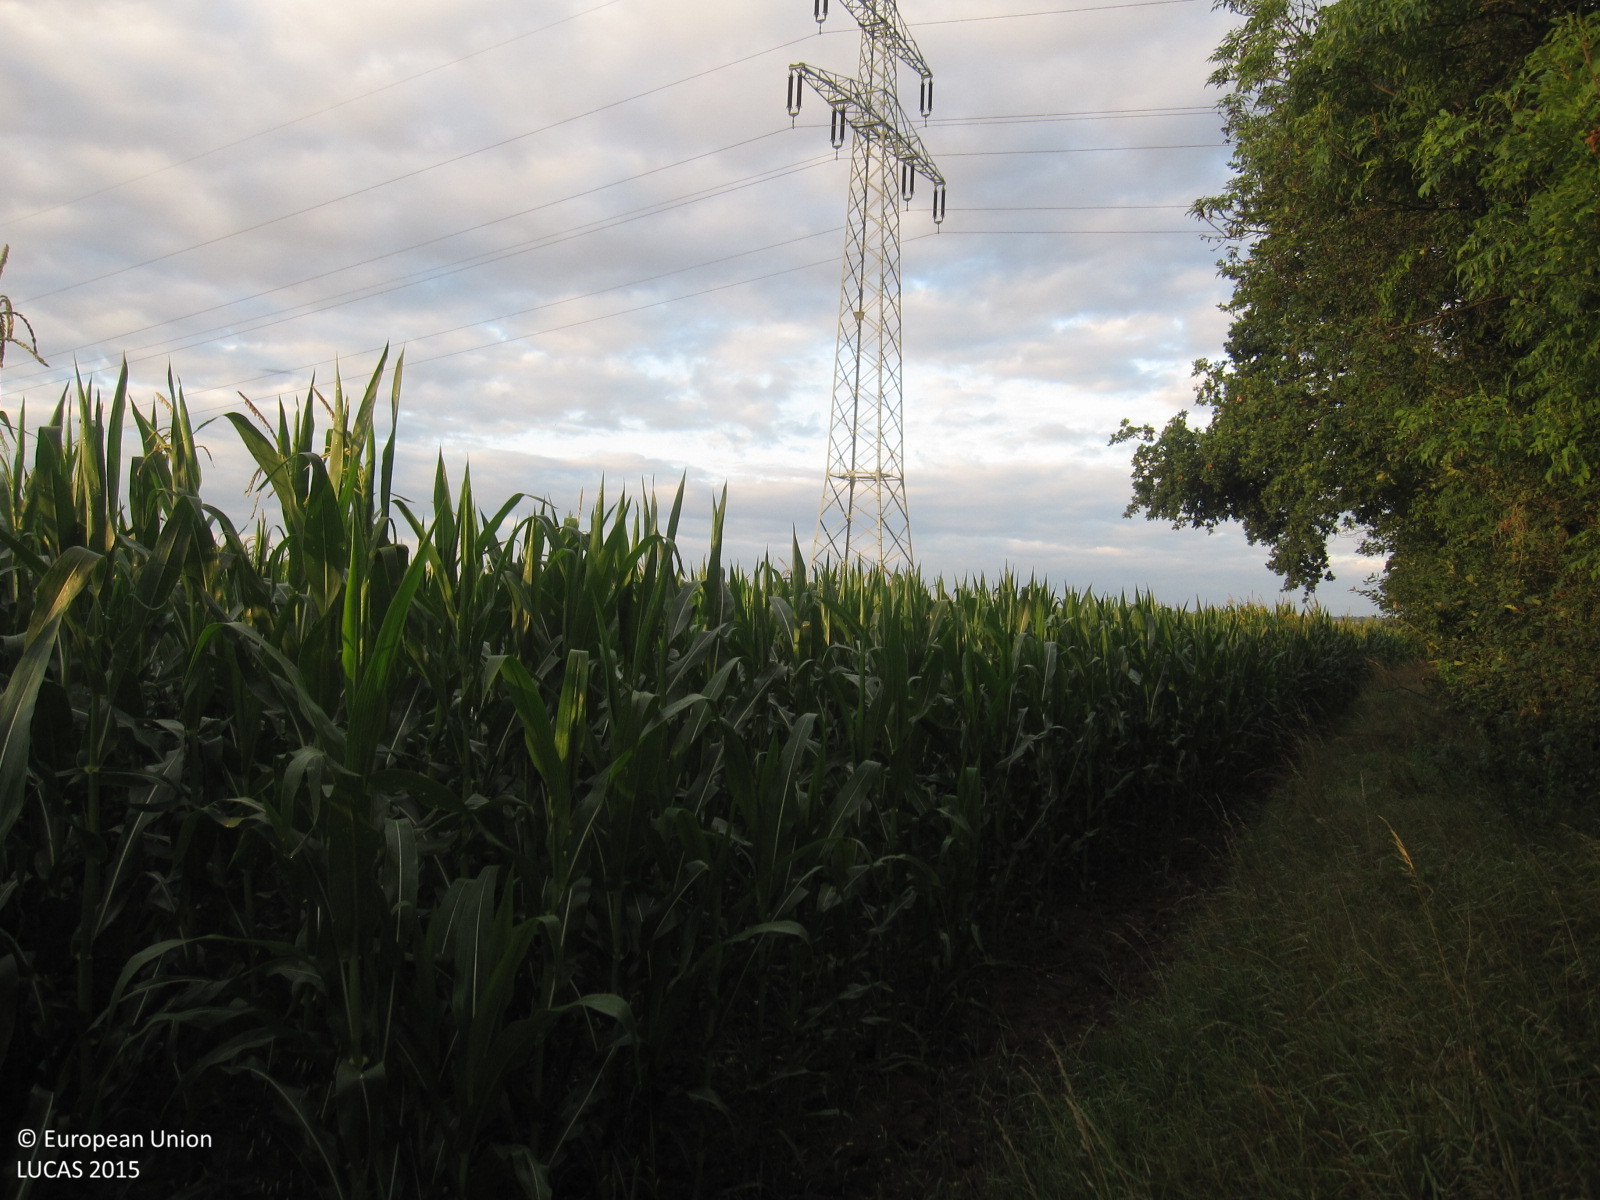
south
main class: Cropland
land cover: Maize
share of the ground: > 75 %
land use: Agriculture (excluding fallow land and kitchen gardens)
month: July
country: DE
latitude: 51.0807
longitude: 12.1837
